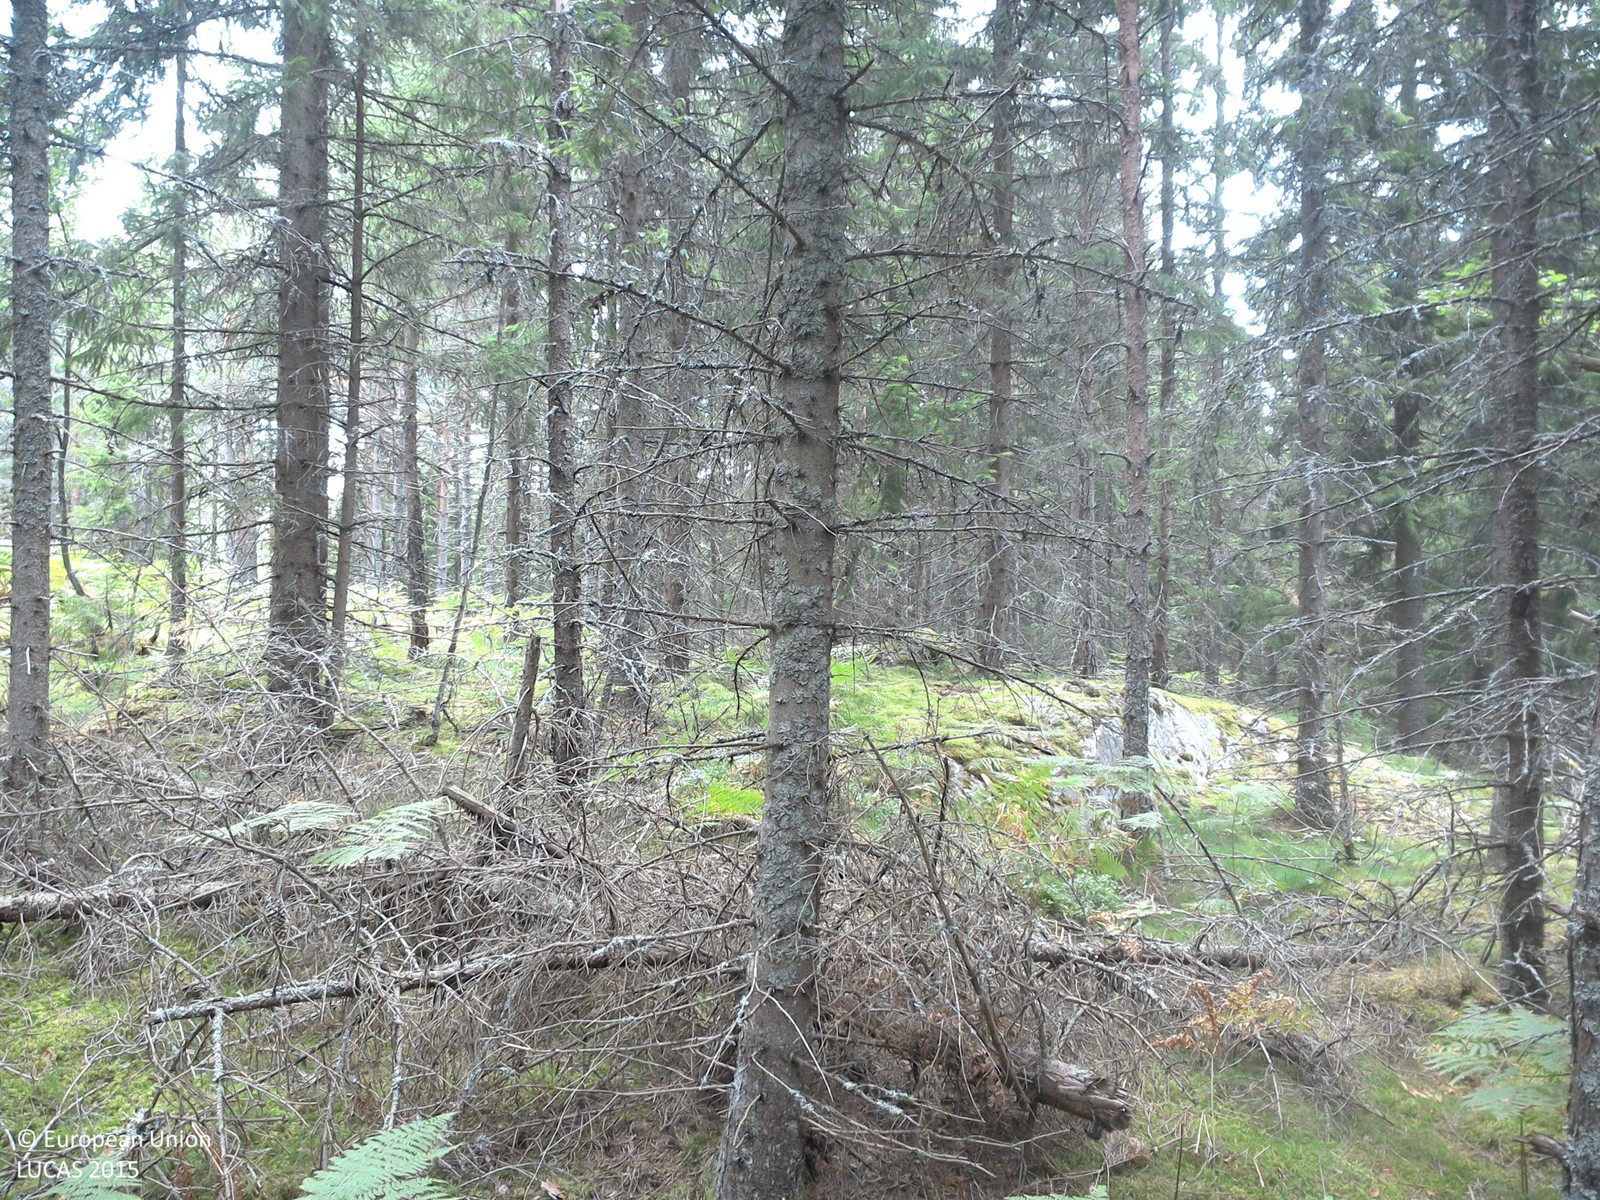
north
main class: Woodland
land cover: Spruce dominated coniferous woodland
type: boreal forest
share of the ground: 50 - 75 %
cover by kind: coniferous forest trees 60 %, herbaceous plants 30 %, lichens and mosses 10 %
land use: Forestry
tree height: > 5 m
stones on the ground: < 10 %
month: August
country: SE
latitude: 57.8888
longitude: 15.5451
